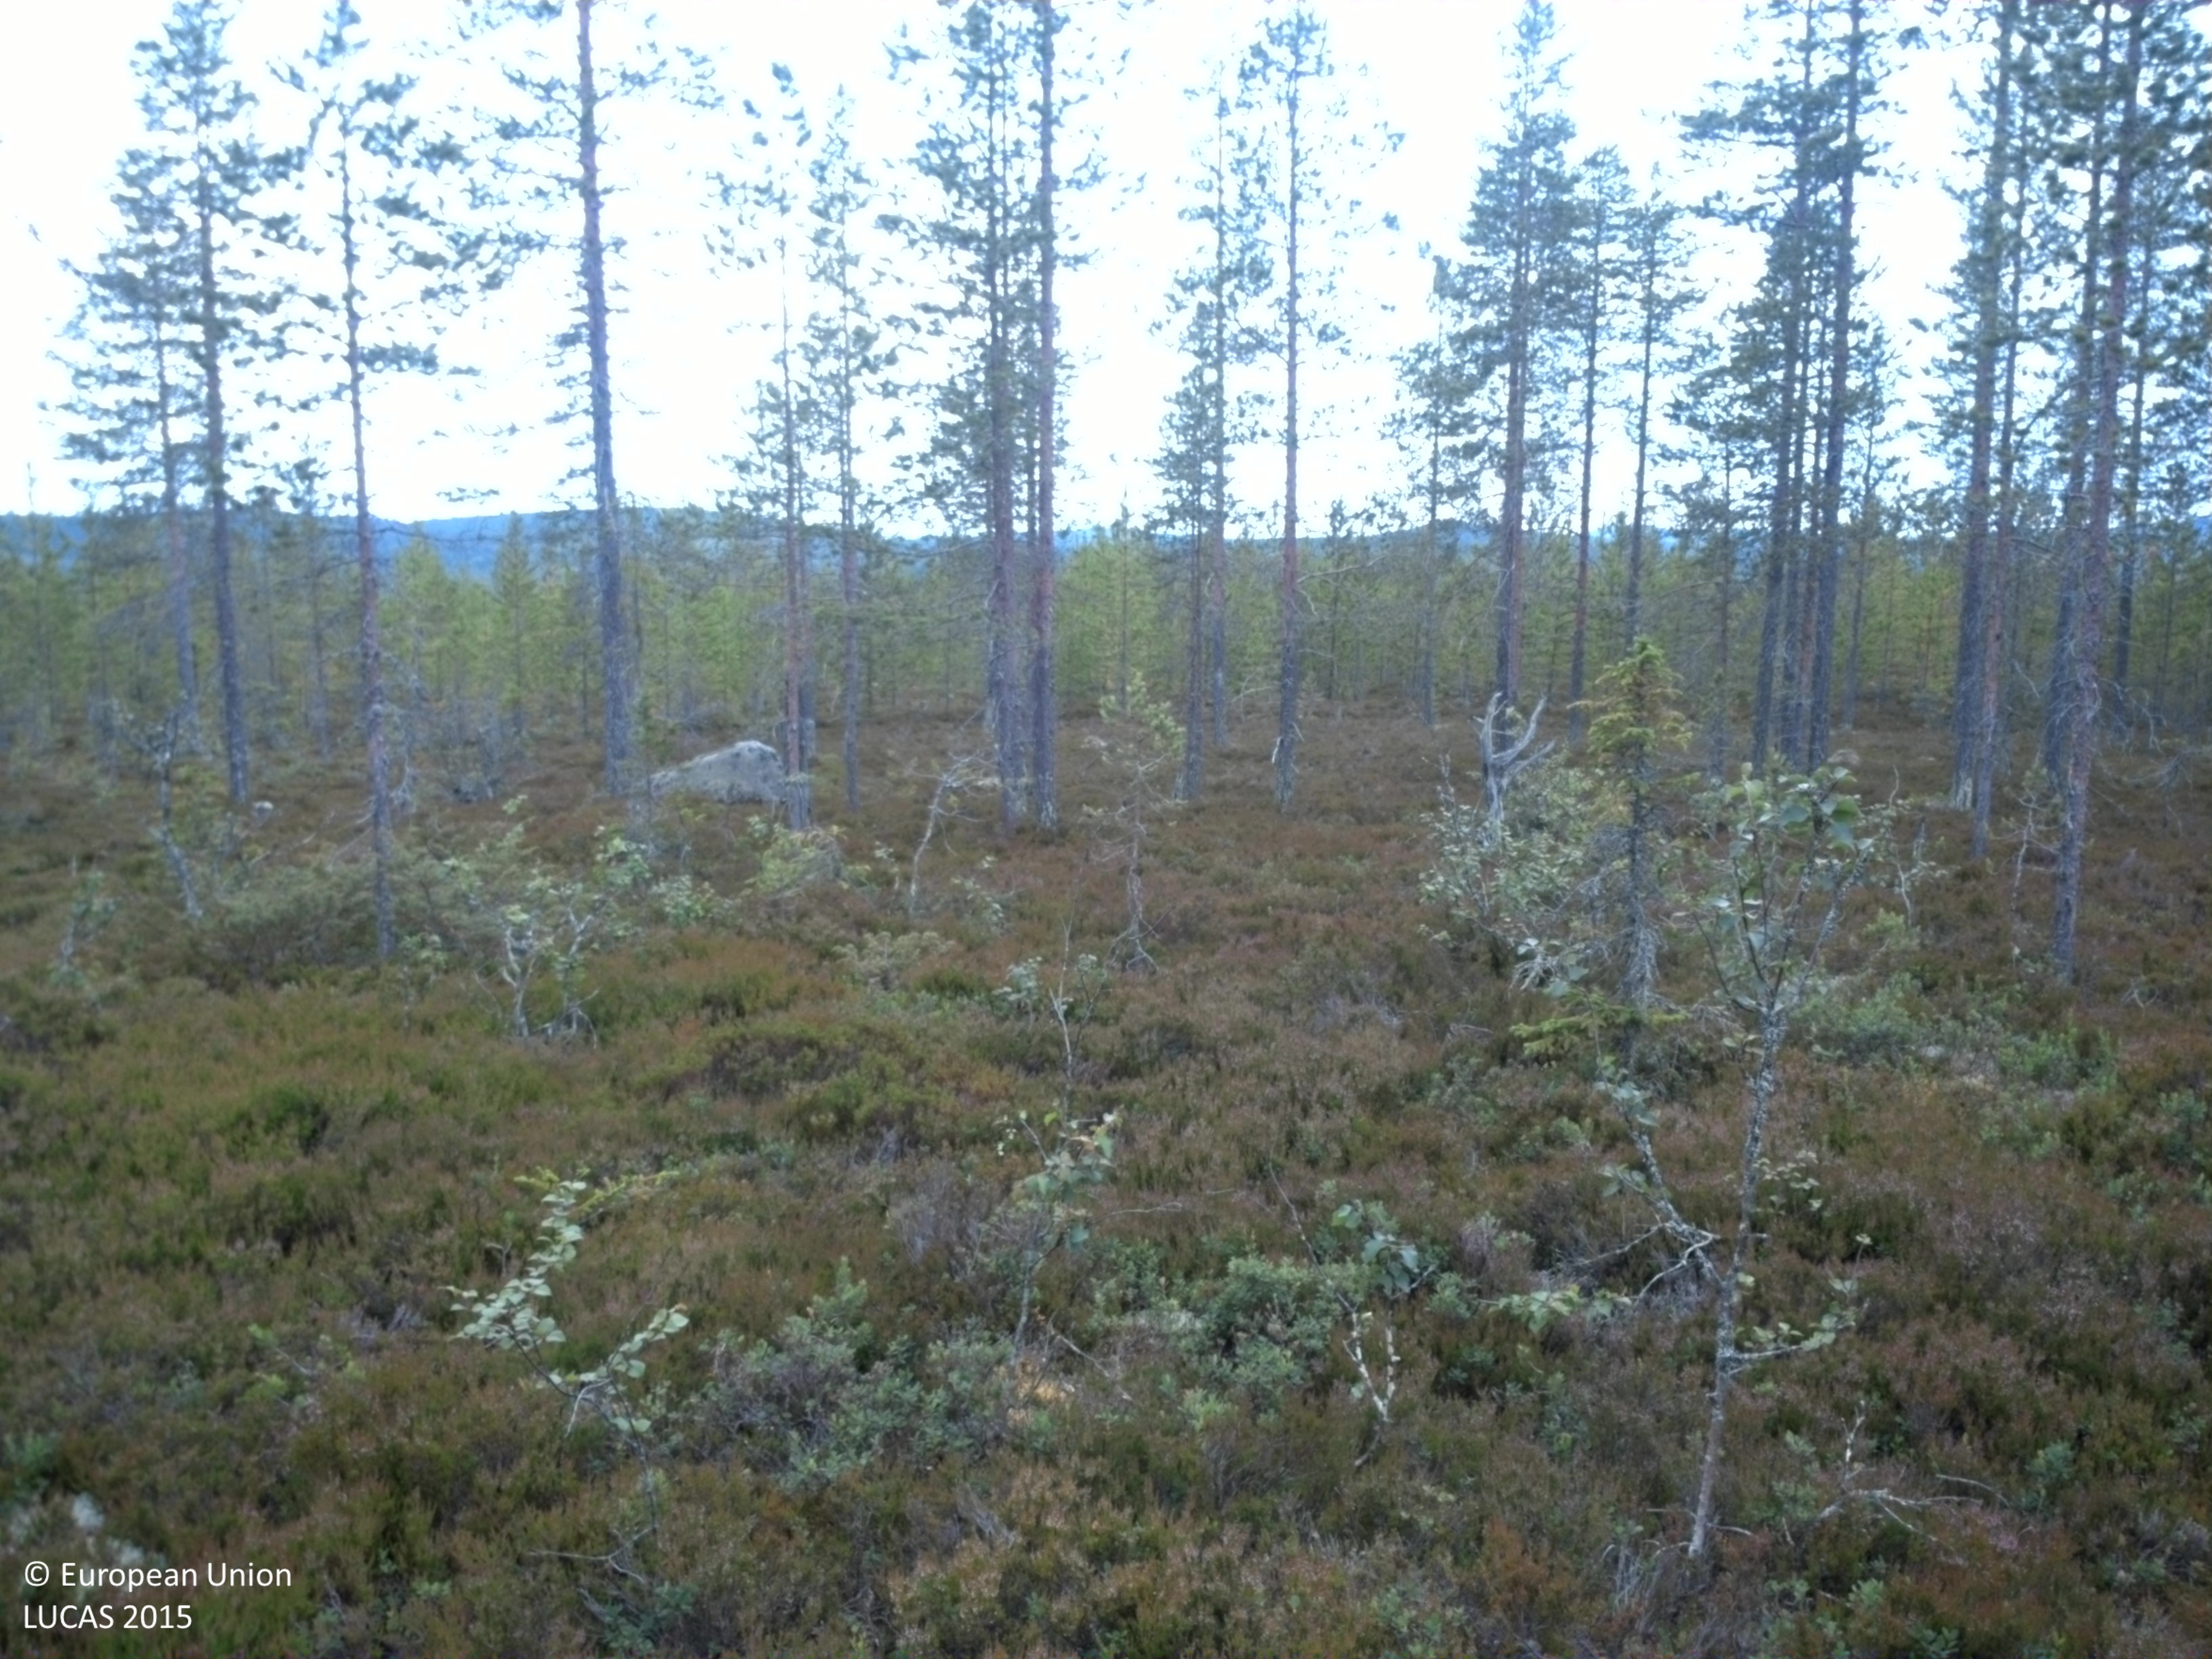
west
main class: Woodland
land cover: Pine dominated coniferous woodland
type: exotic forest
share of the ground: 25 - 50 %
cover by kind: coniferous forest trees 50 %, shrubs 45 %, lichens and mosses 5 %
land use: Forestry
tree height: > 5 m
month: August
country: SE
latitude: 61.6122
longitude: 14.3028
